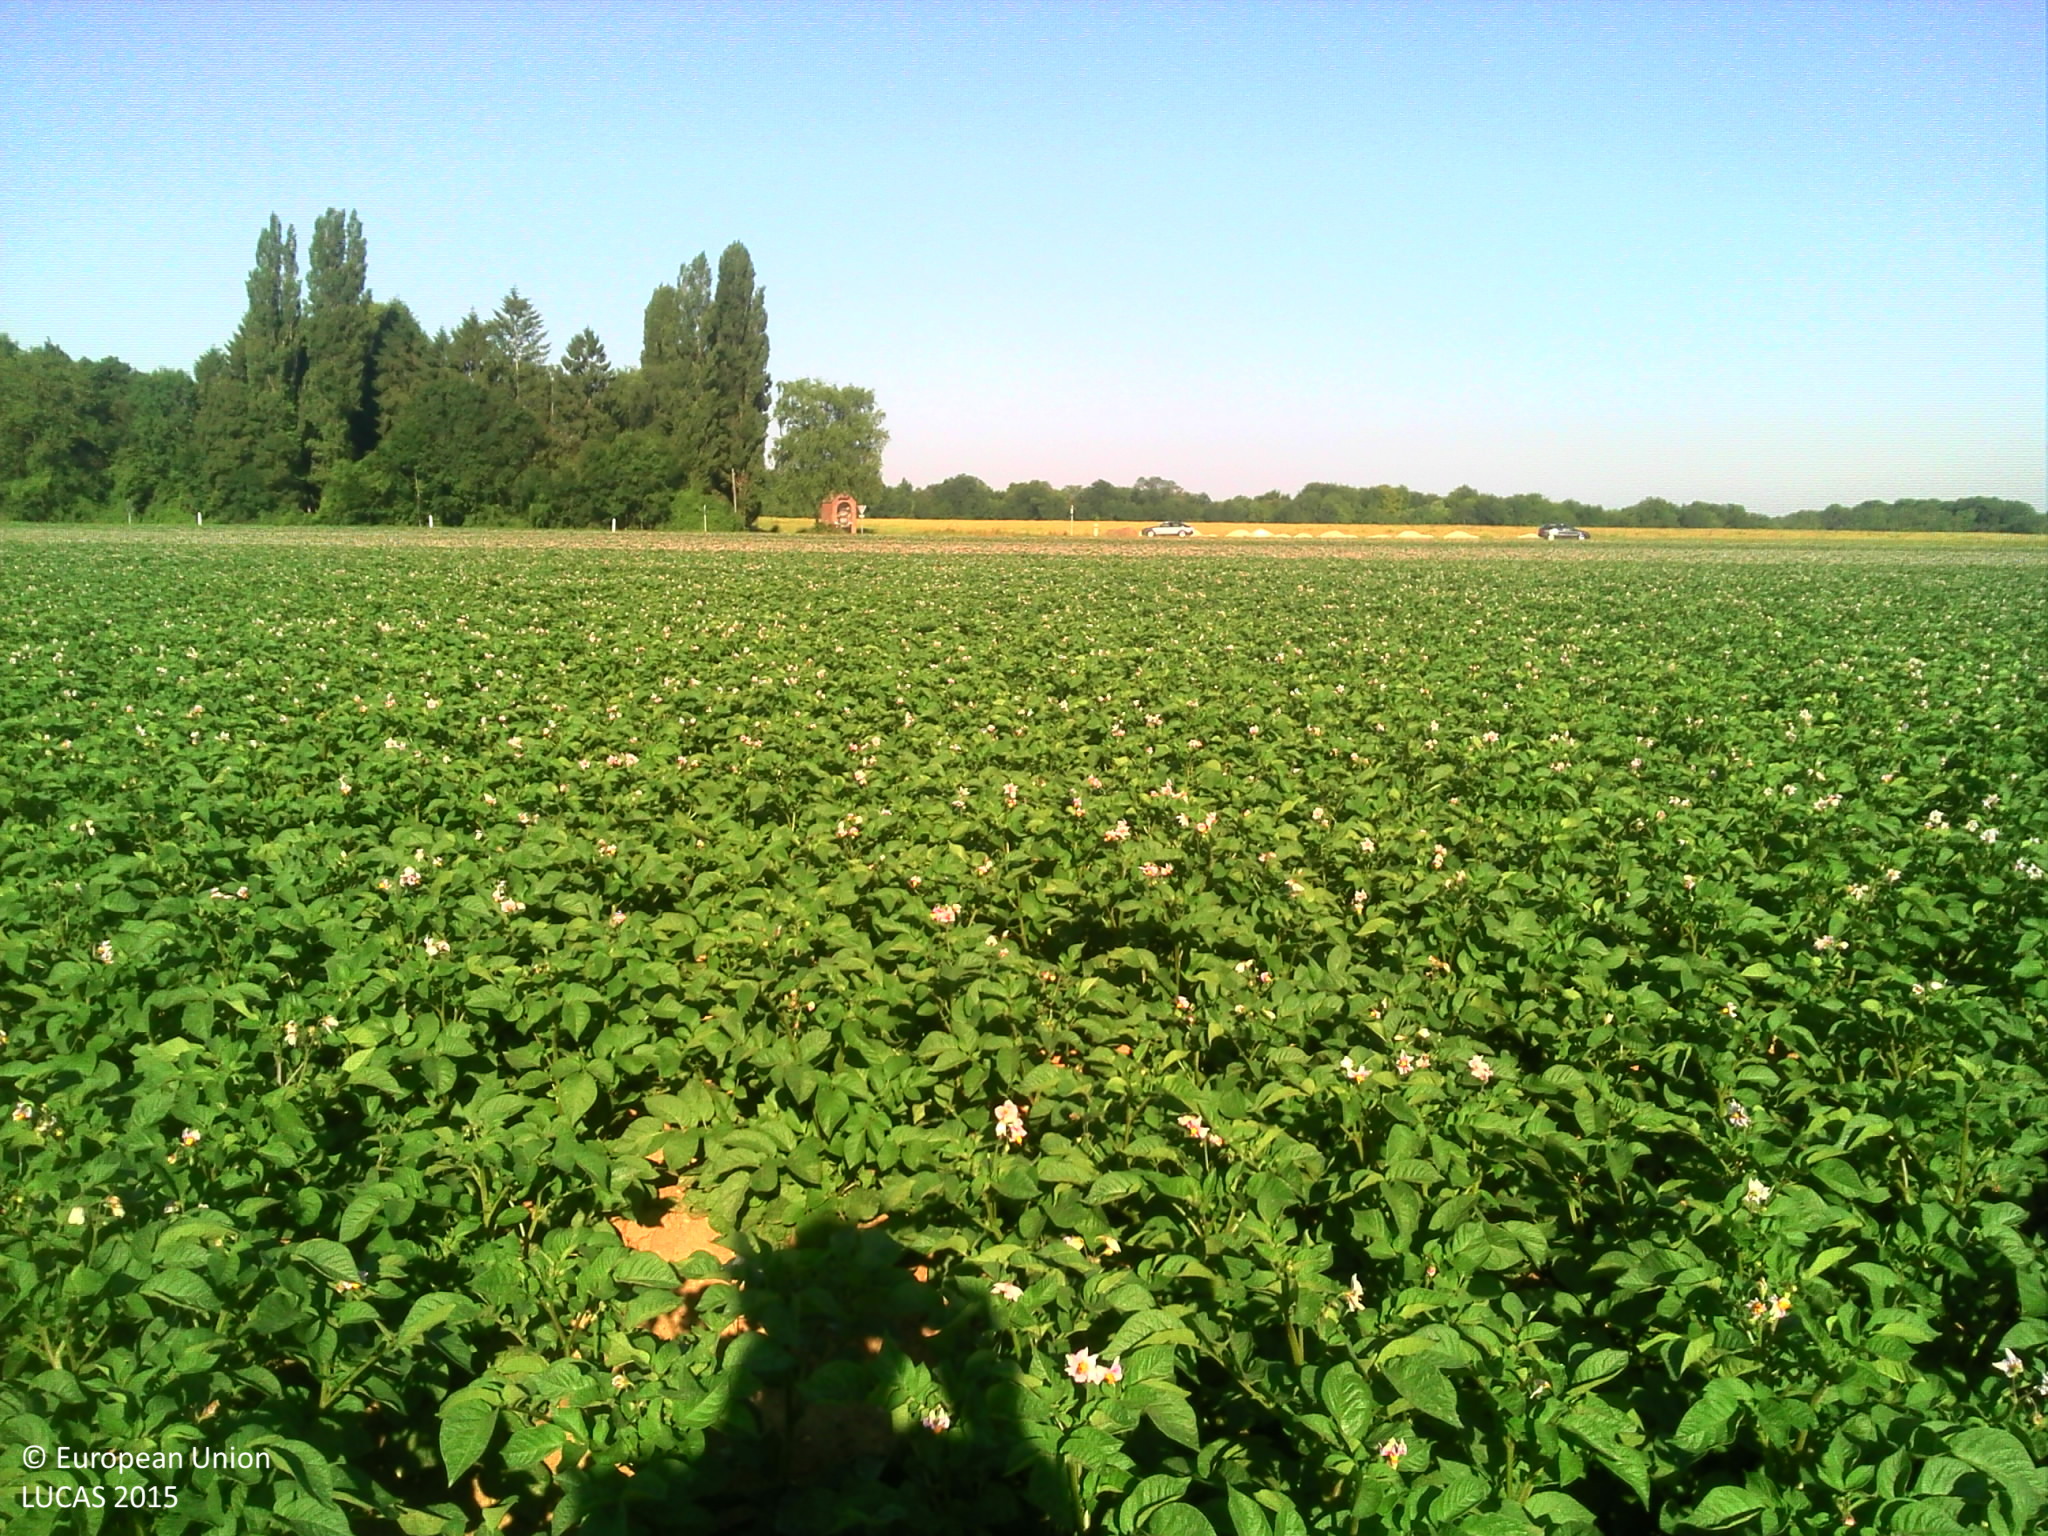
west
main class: Cropland
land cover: Potatoes
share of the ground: > 75 %
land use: Agriculture (excluding fallow land and kitchen gardens)
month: June
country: FR
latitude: 49.8313
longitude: 2.2706
